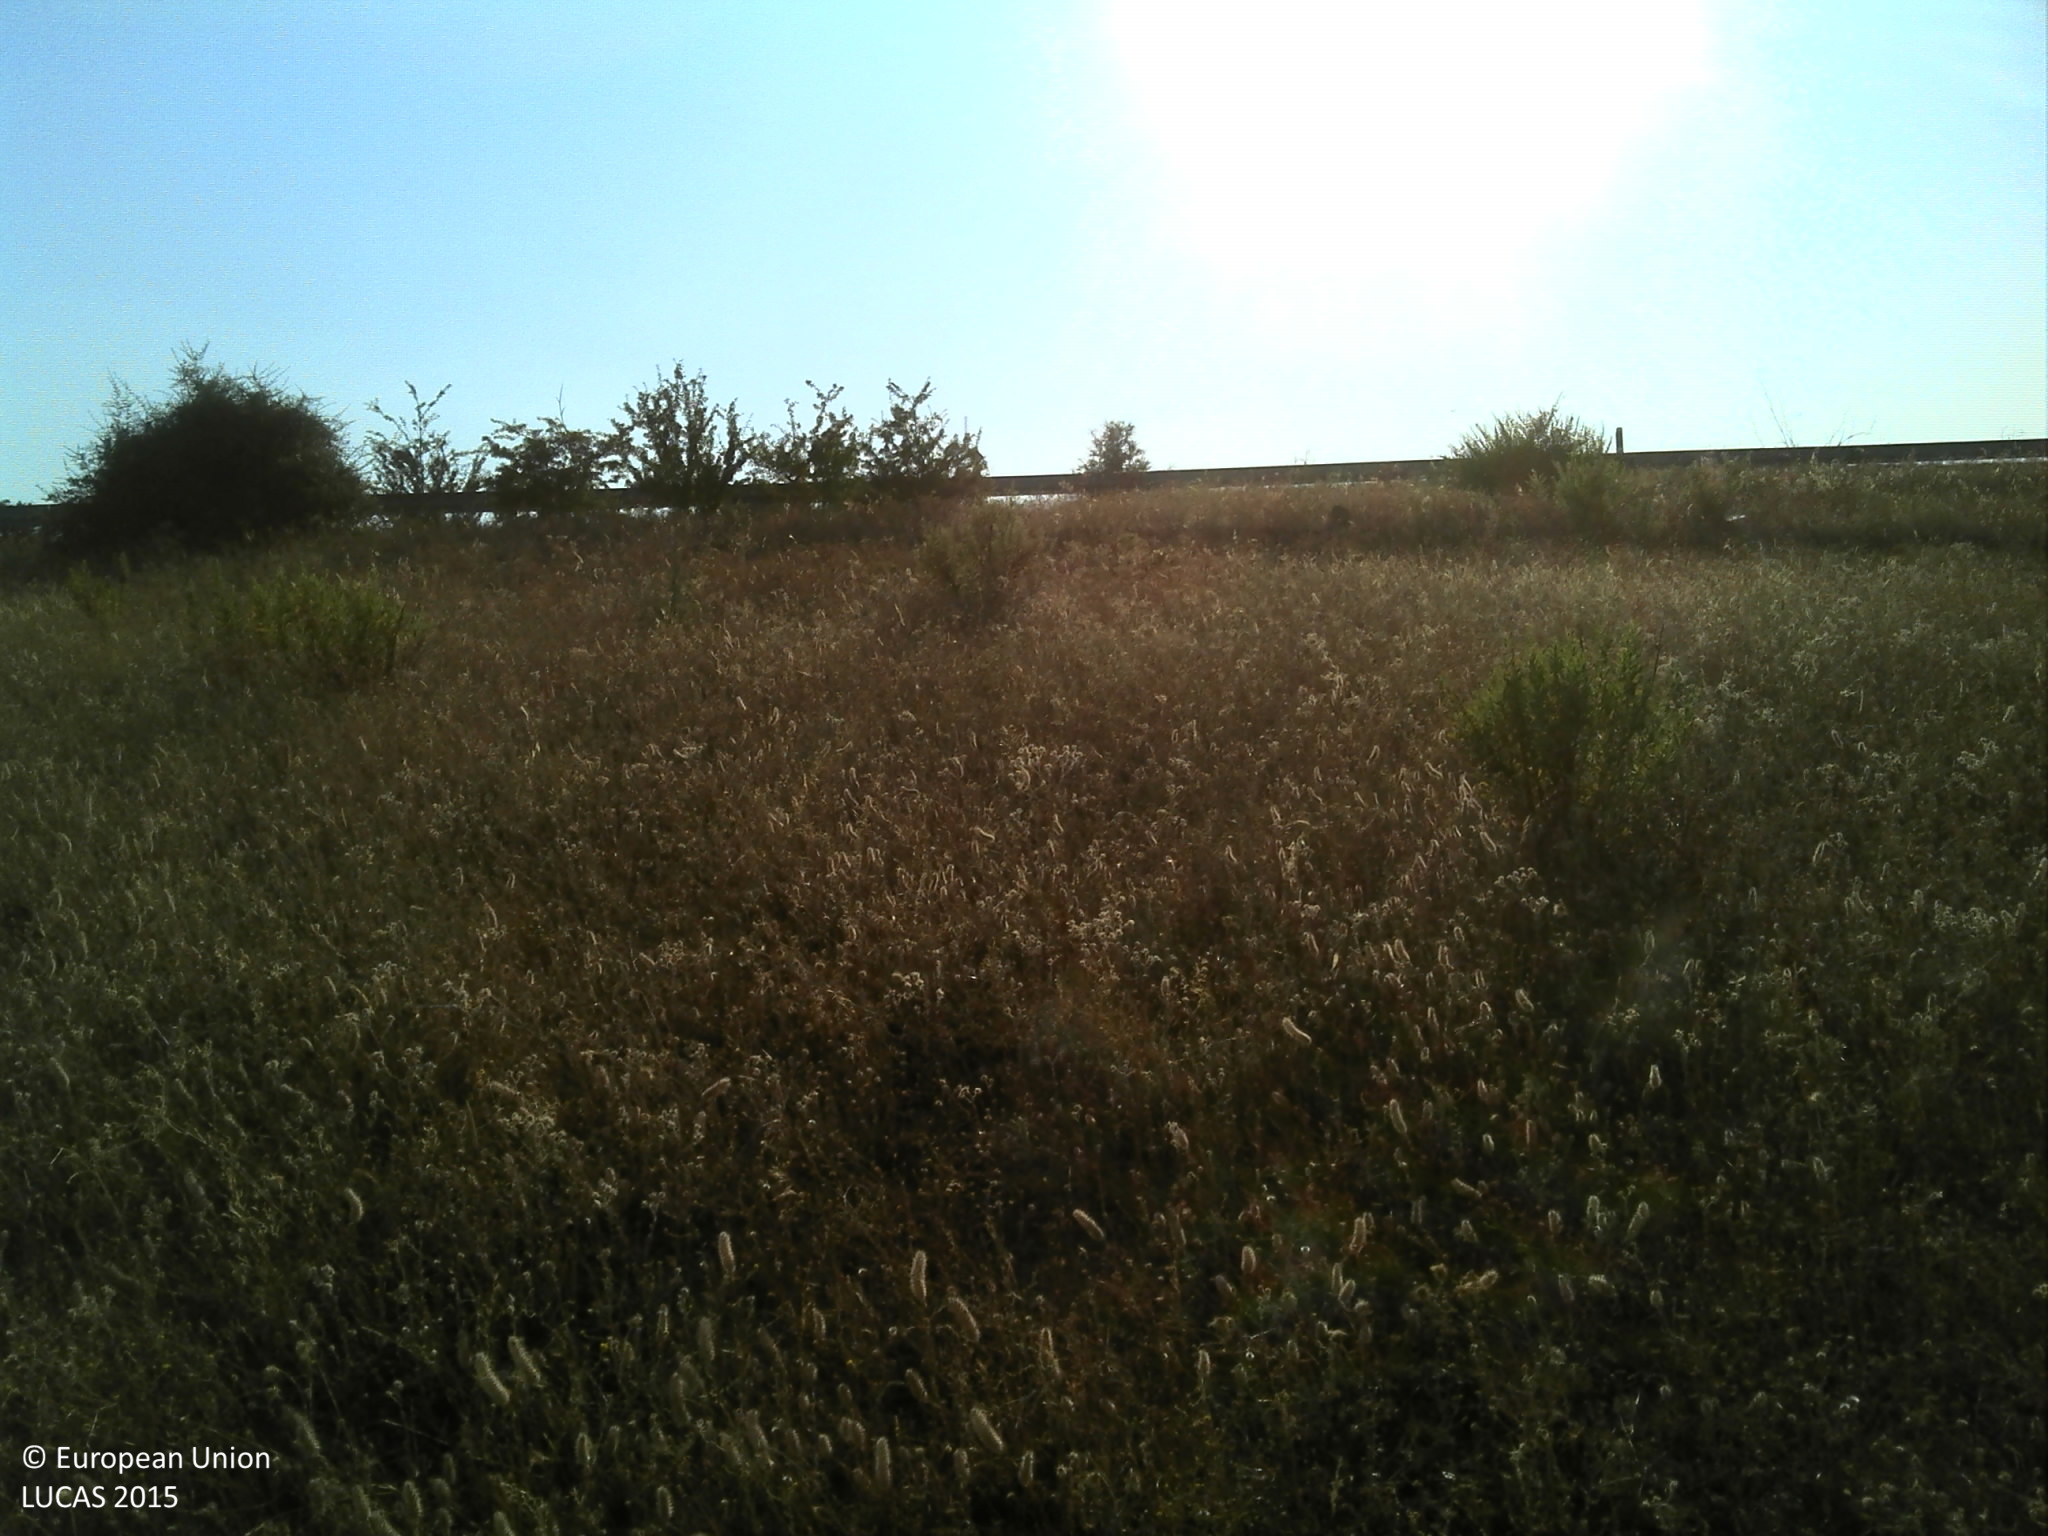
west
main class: Grassland
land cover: Grassland without tree/shrub cover
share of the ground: > 75 %
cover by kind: herbaceous plants 100 %
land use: Agriculture (excluding fallow land and kitchen gardens)
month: June
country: PT
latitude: 38.3244
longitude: -7.3281
